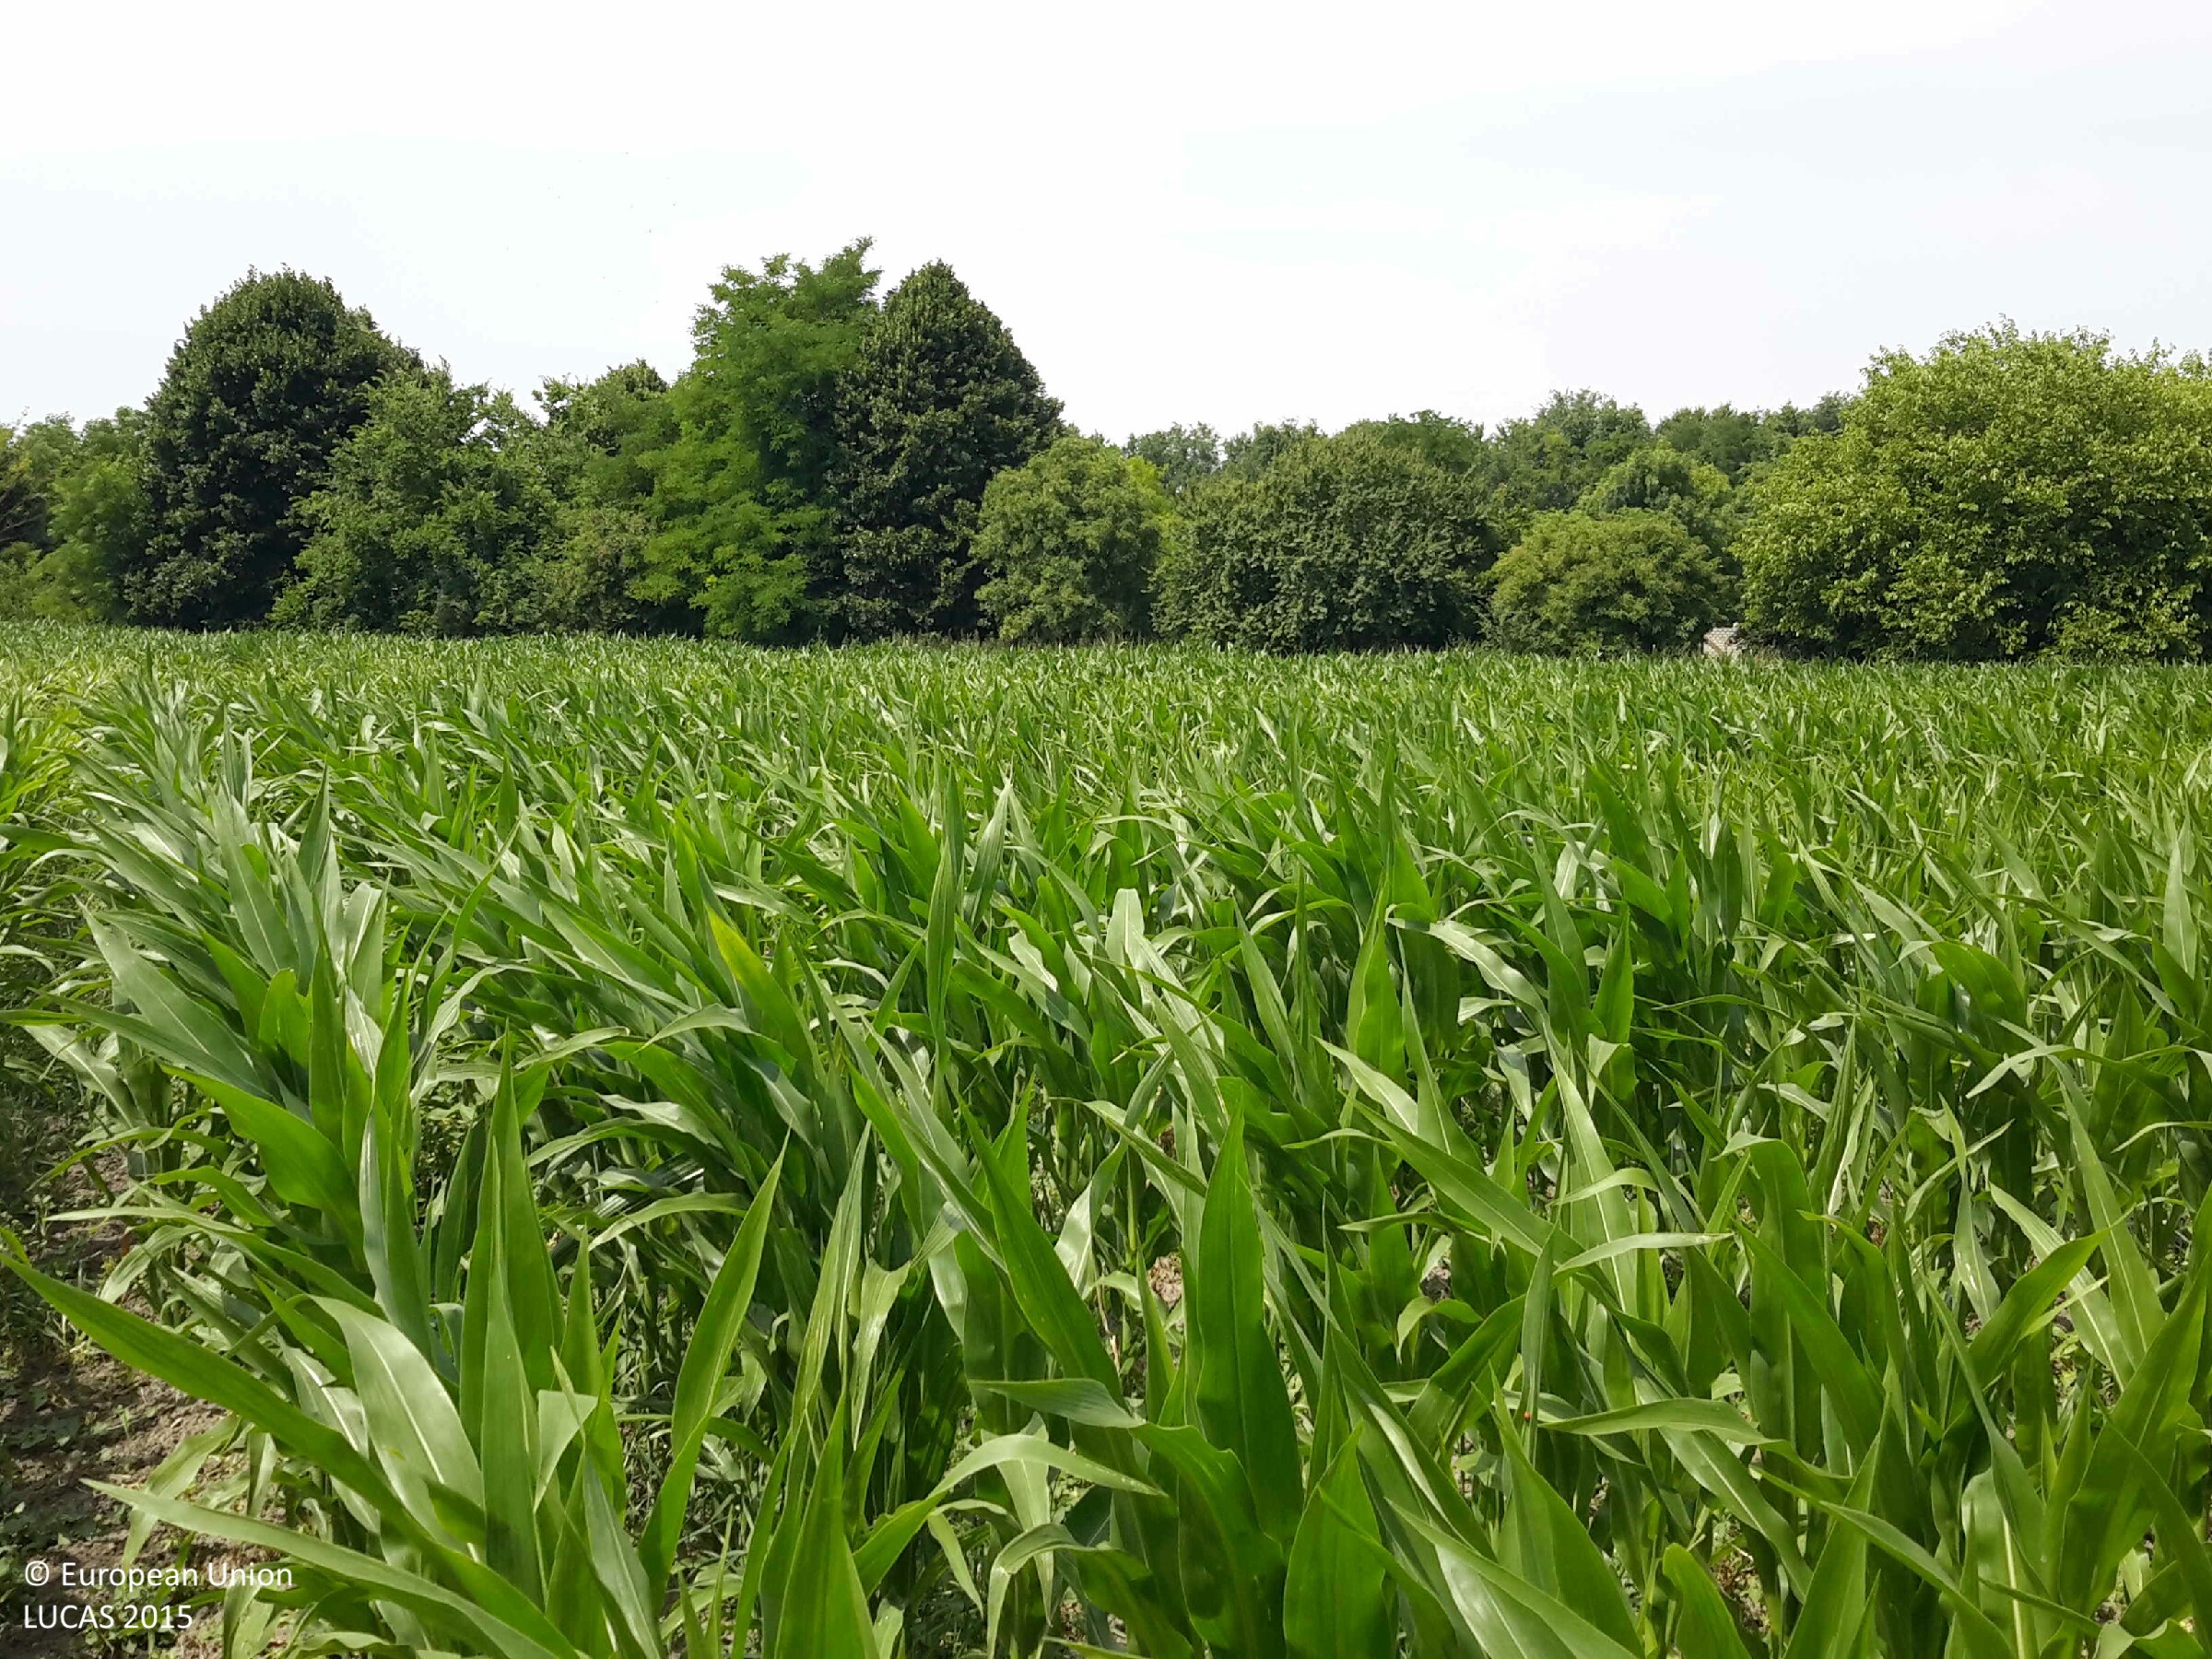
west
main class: Cropland
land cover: Maize
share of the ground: 50 - 75 %
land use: Agriculture (excluding fallow land and kitchen gardens)
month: June
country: HU
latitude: 47.3024
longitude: 17.4534
